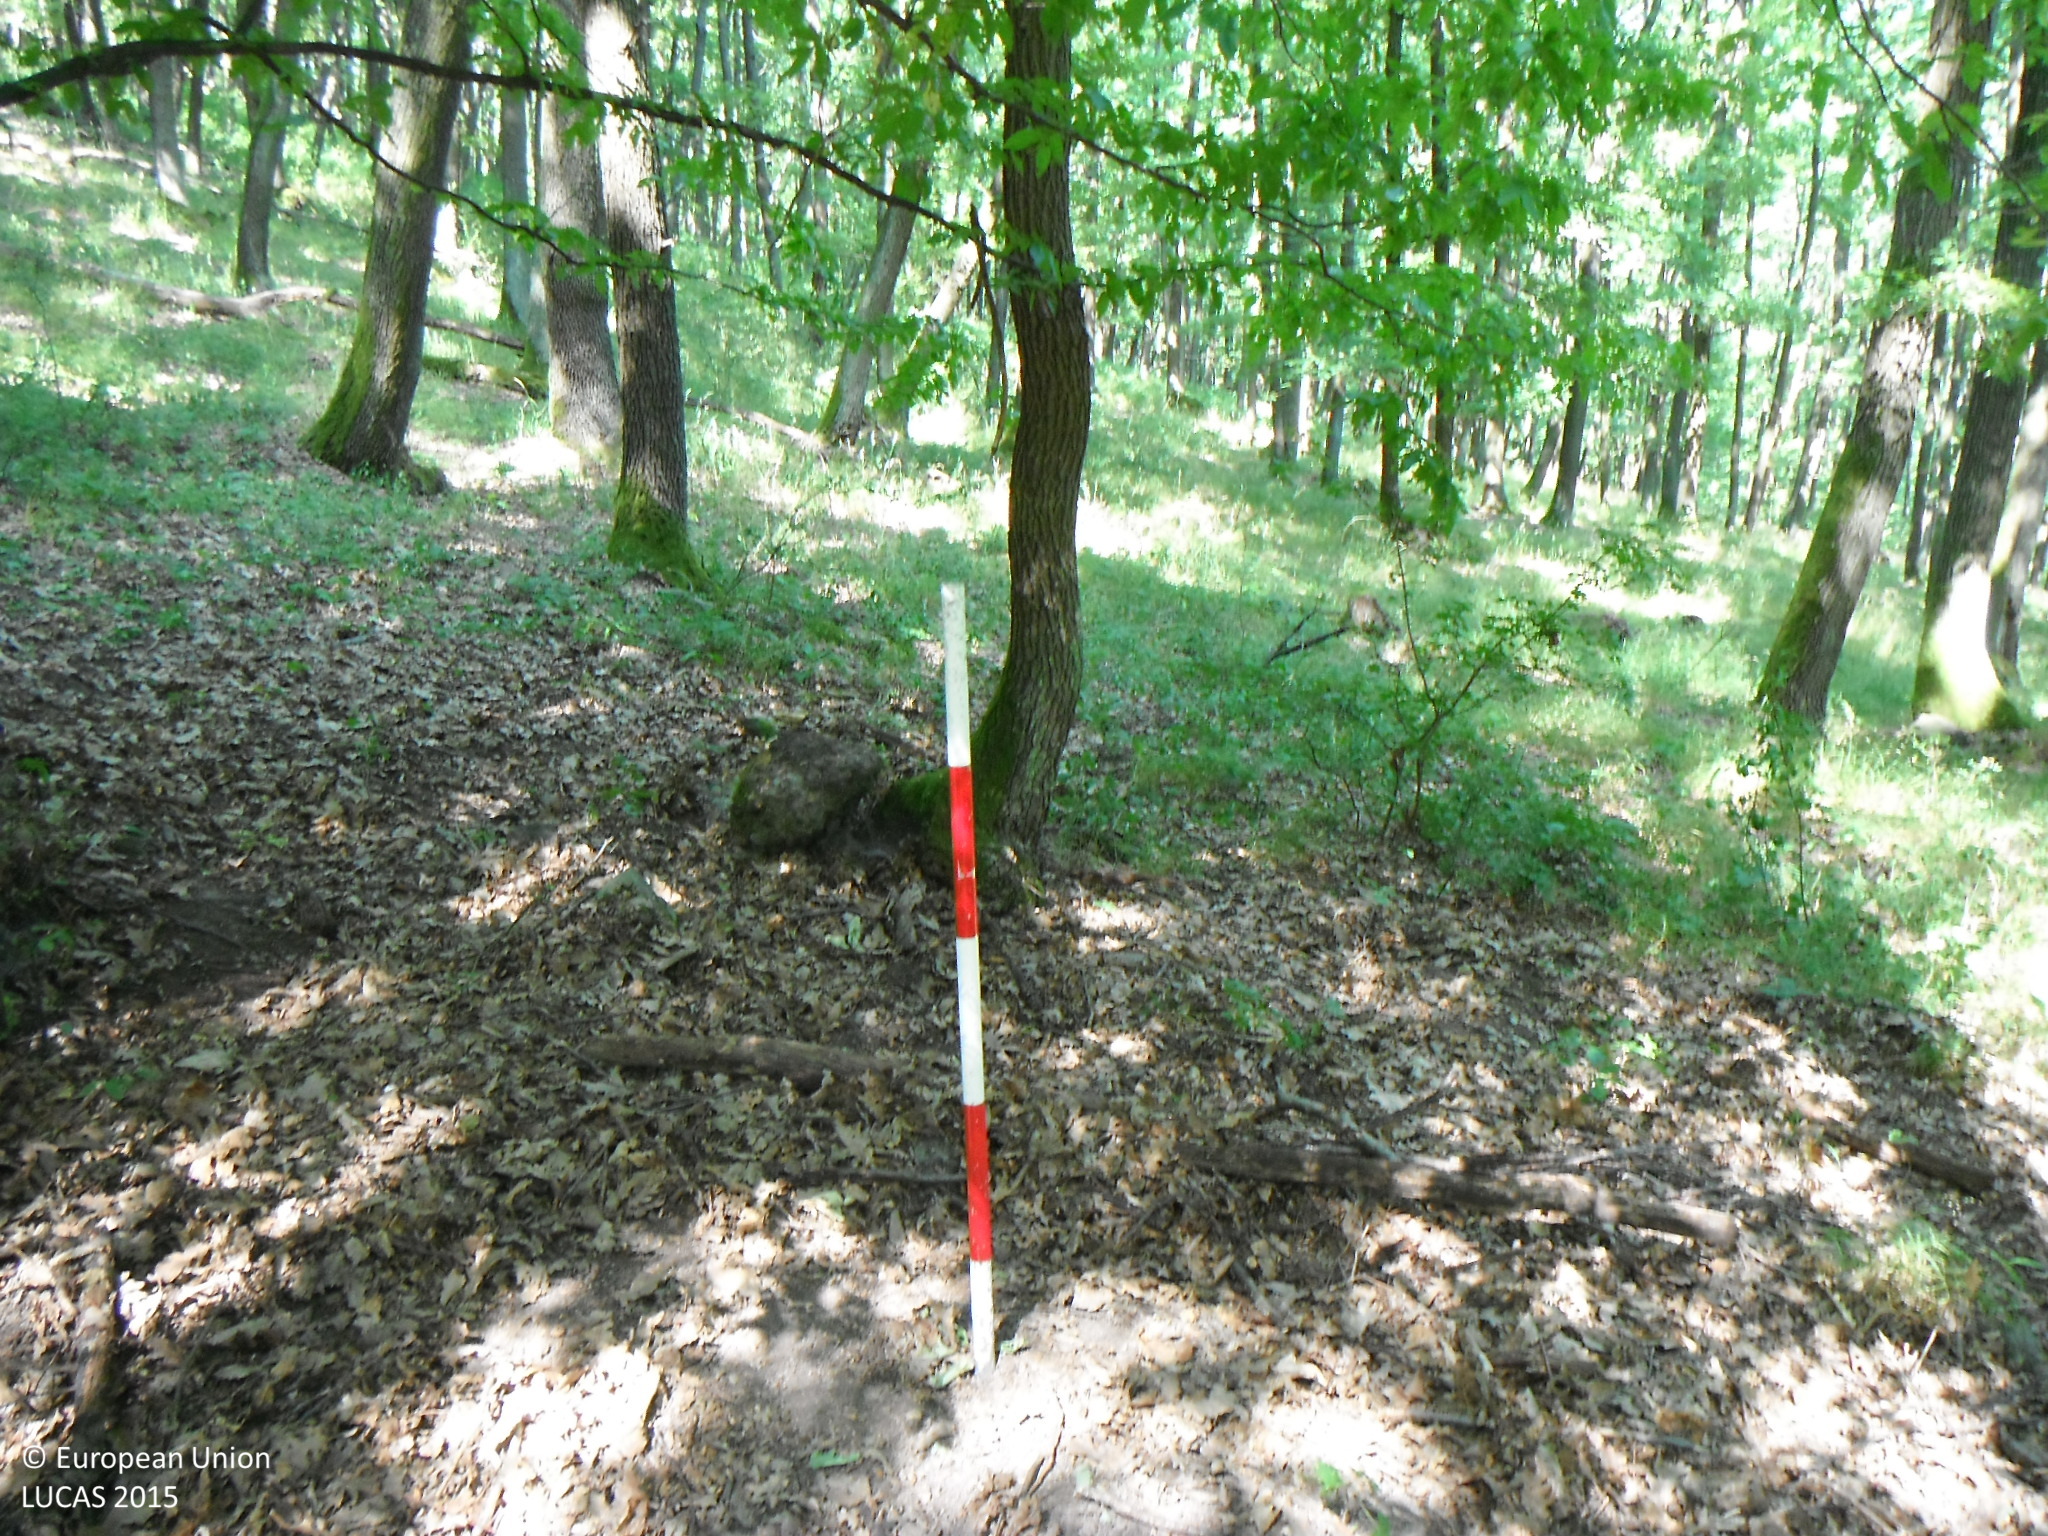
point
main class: Woodland
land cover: Broadleaved woodland
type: acidophilous oak and oak-birch forest
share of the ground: > 75 %
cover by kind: broadleaved forest trees 100 %
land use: Forestry
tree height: > 5 m
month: July
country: SK
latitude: 48.1370
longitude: 19.0910
